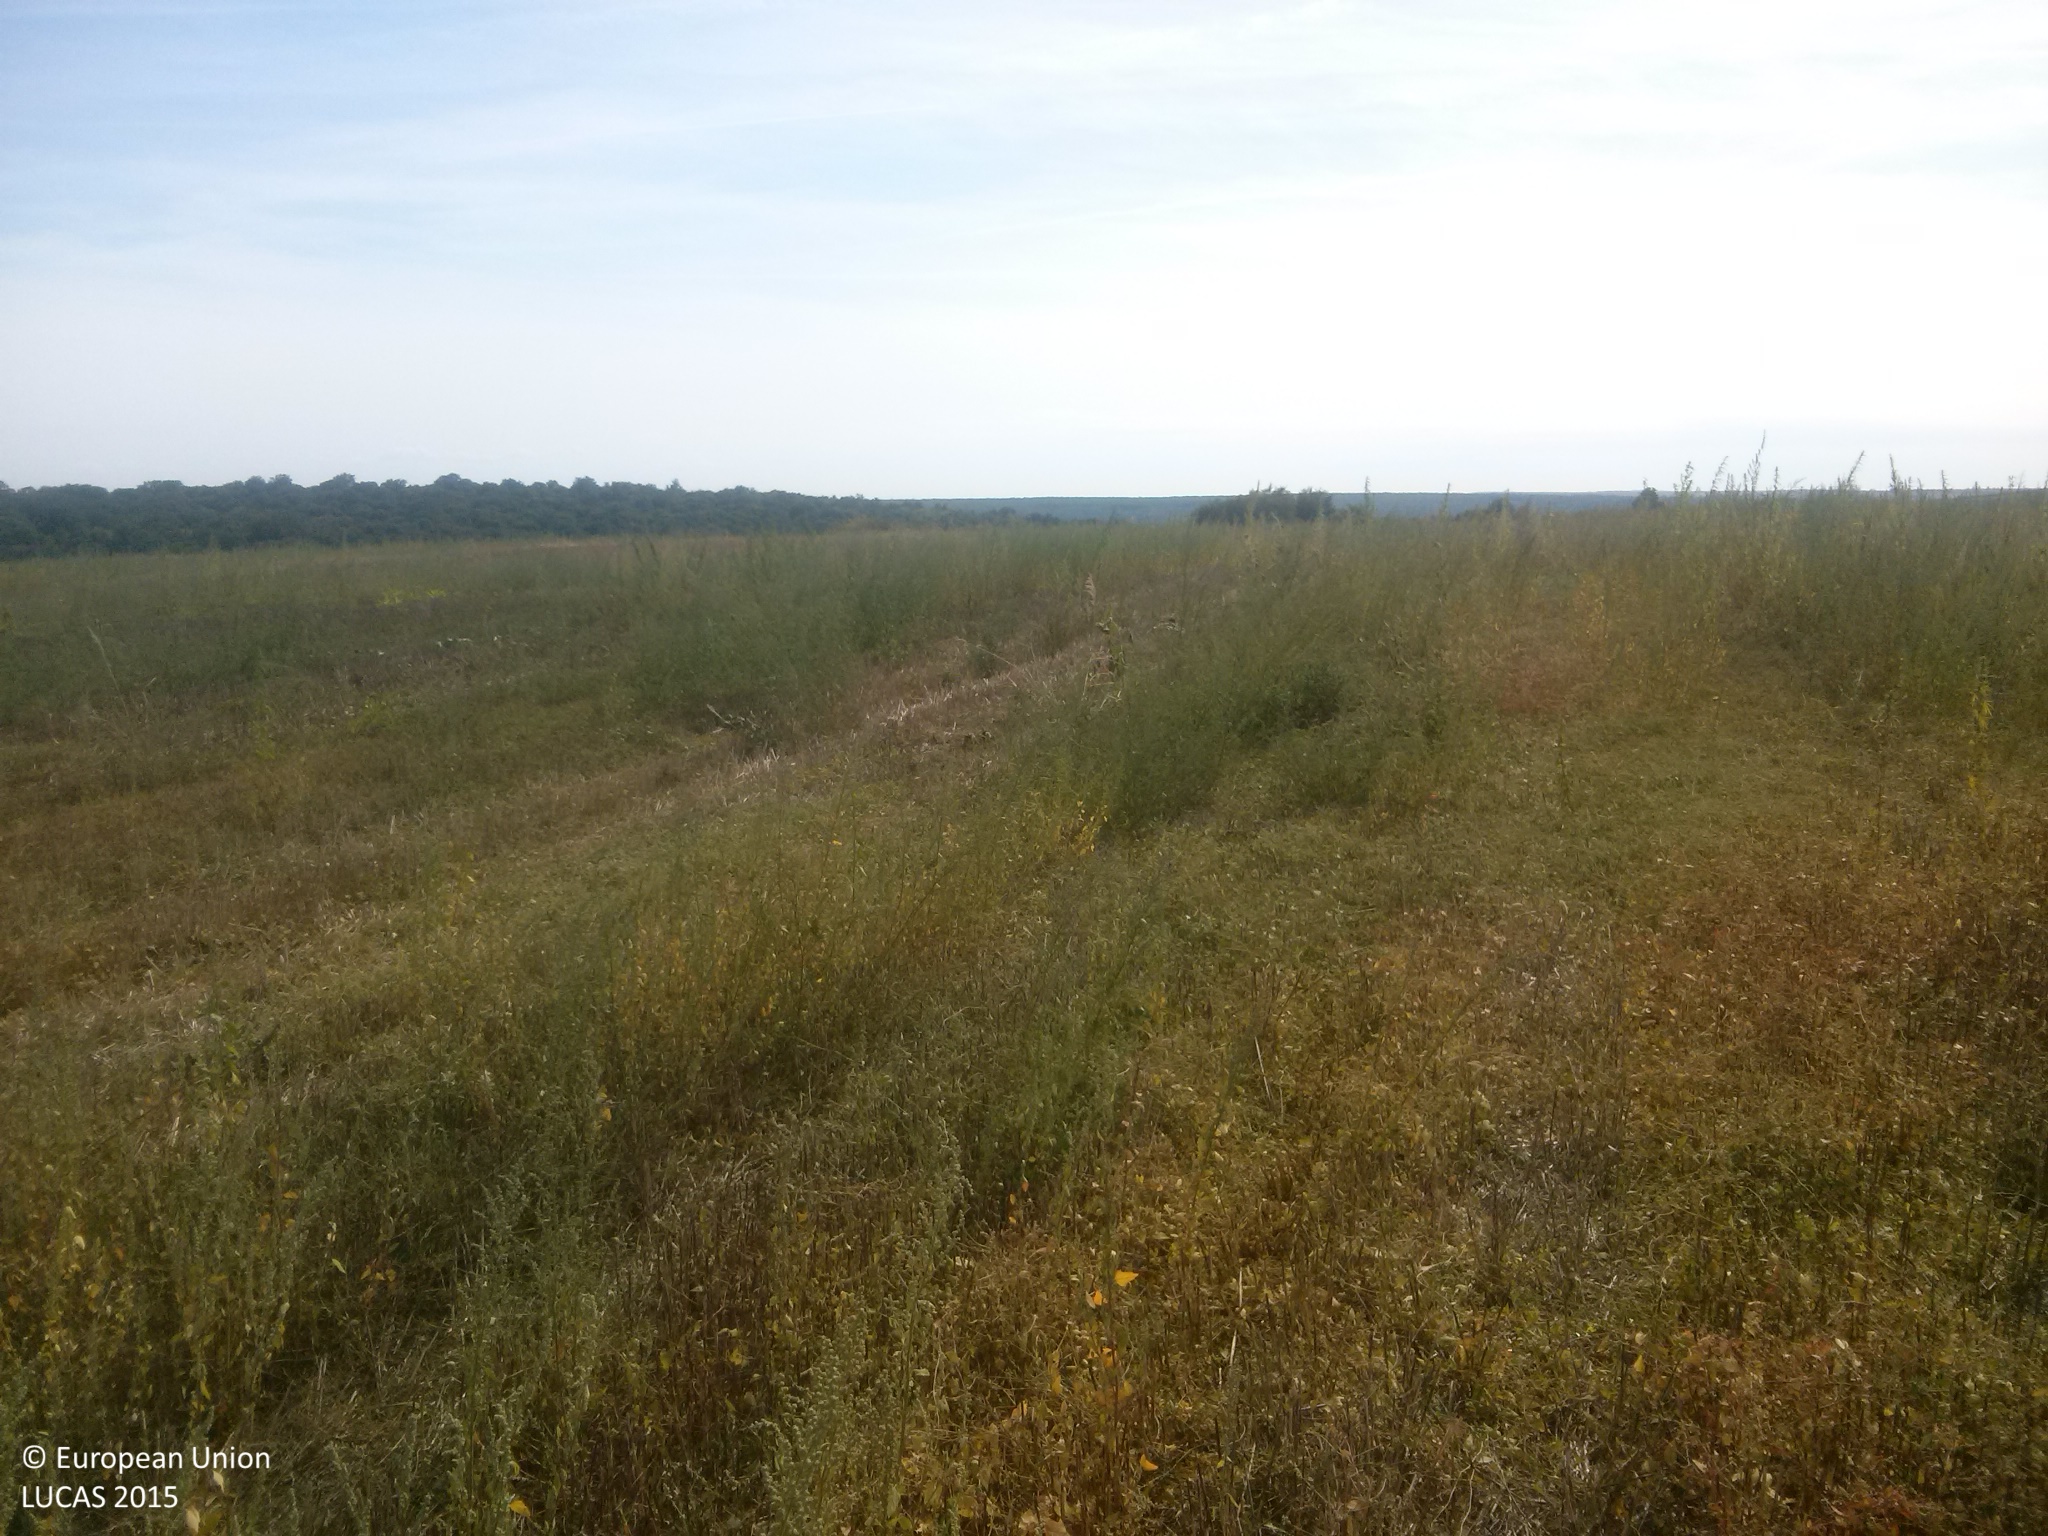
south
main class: Cropland
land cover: Common wheat
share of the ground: 25 - 50 %
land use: Agriculture (excluding fallow land and kitchen gardens)
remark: Harvested field
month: September
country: BG
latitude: 43.6855
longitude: 26.2400
